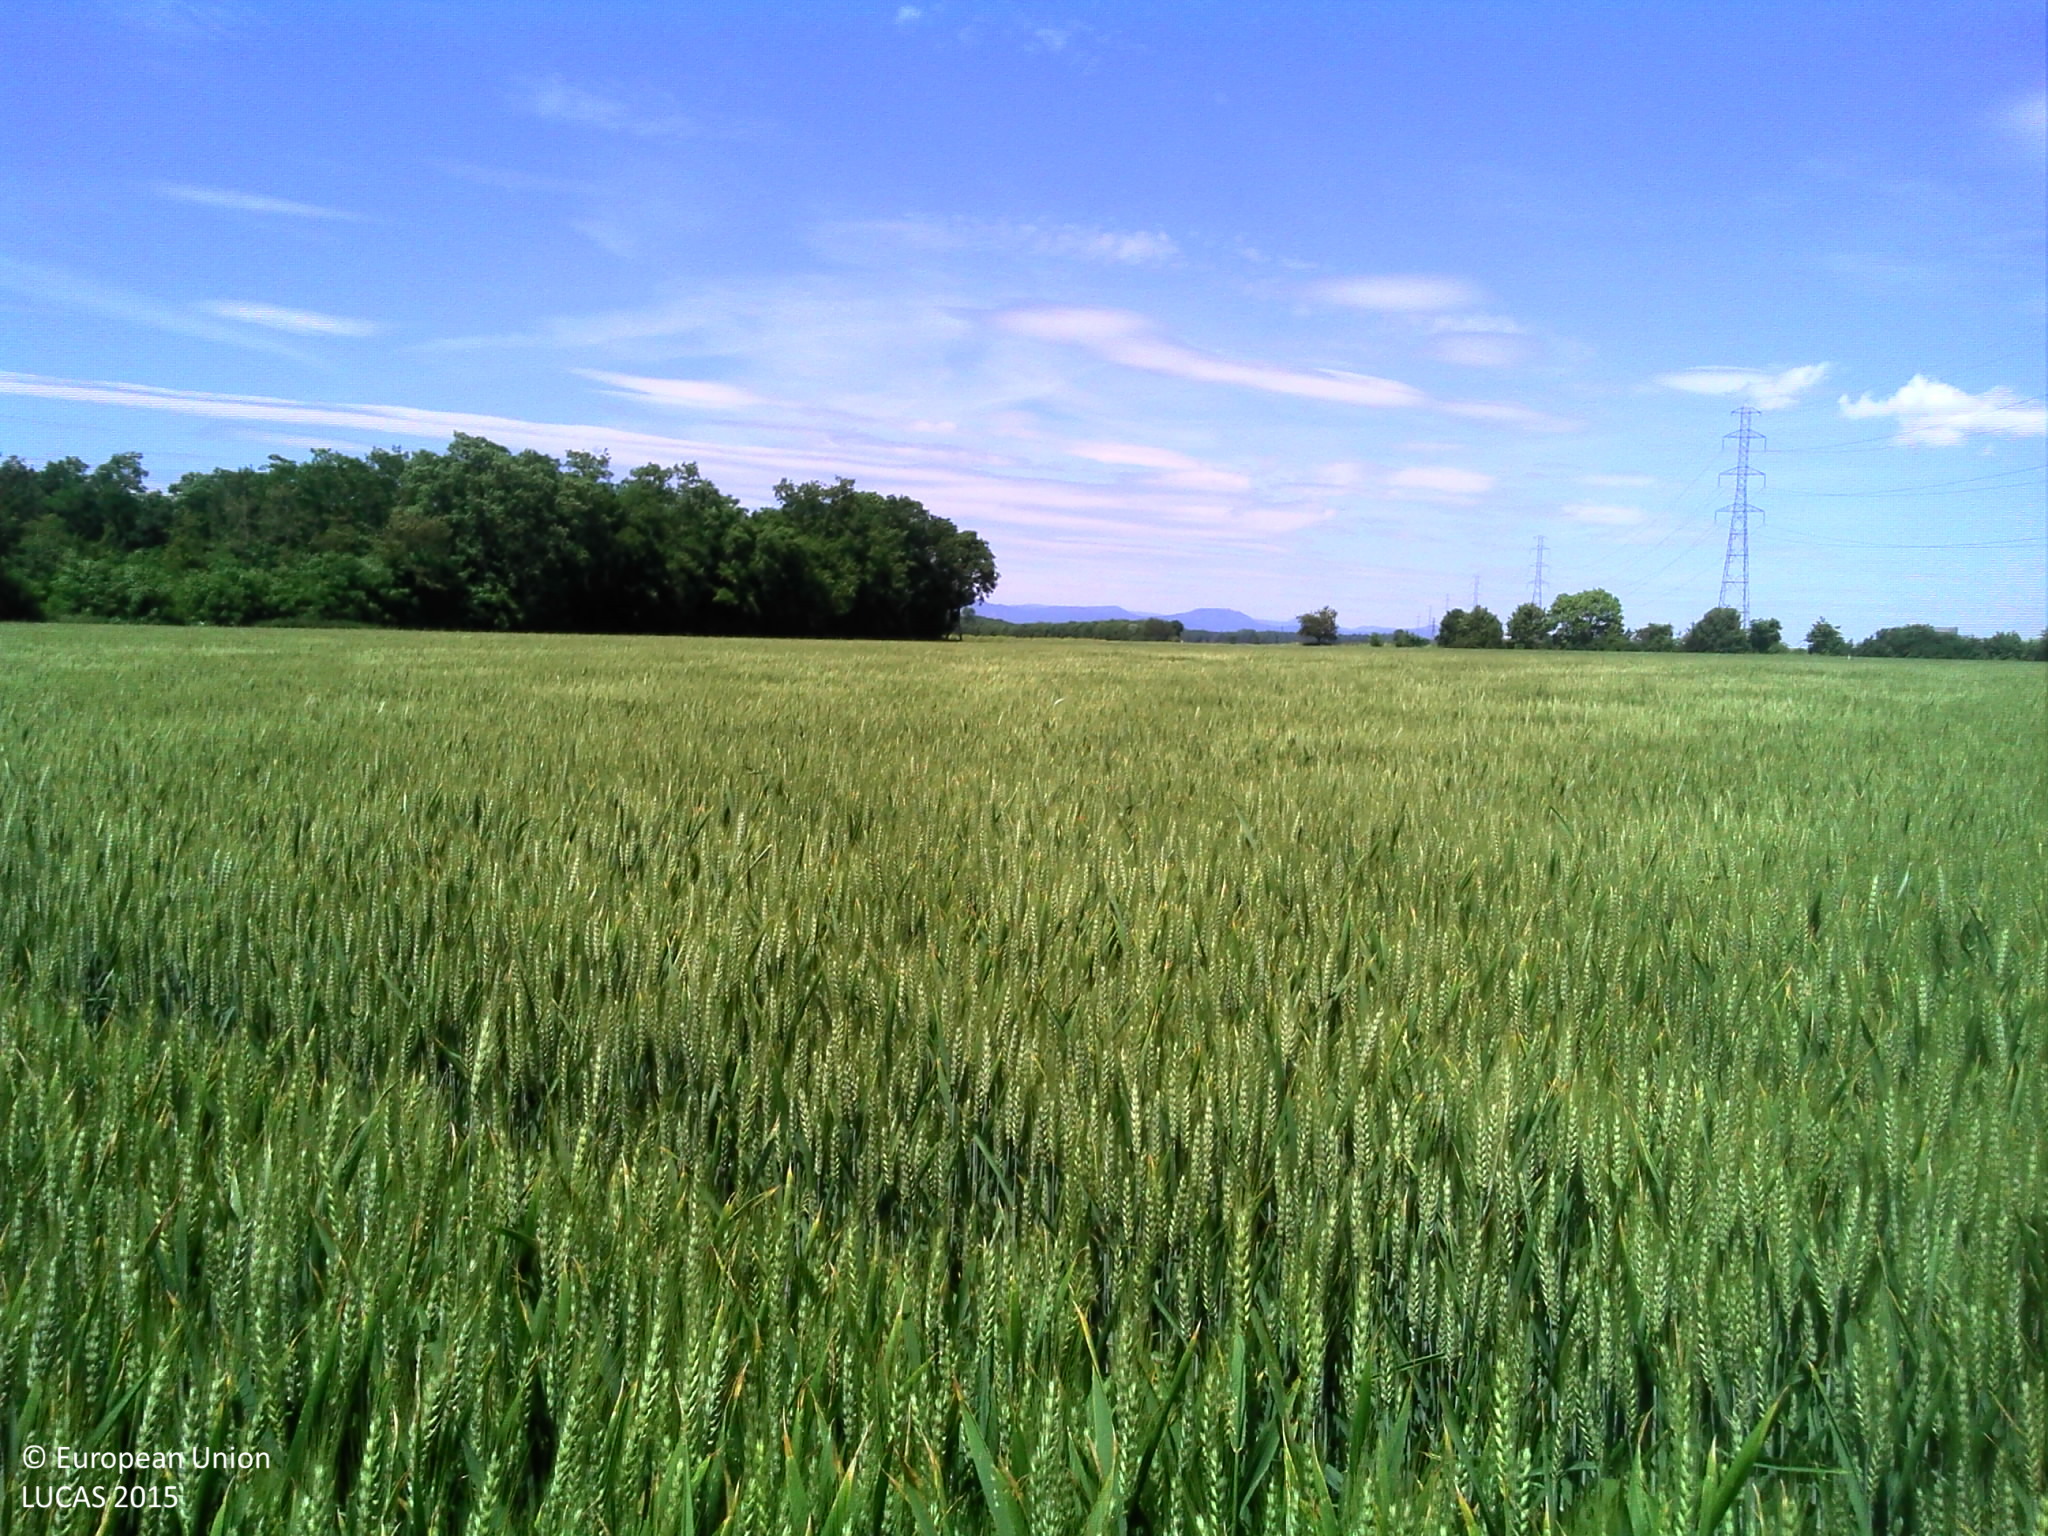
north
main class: Cropland
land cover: Common wheat
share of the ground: > 75 %
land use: Agriculture (excluding fallow land and kitchen gardens)
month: June
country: FR
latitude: 47.9759
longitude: 7.3622
